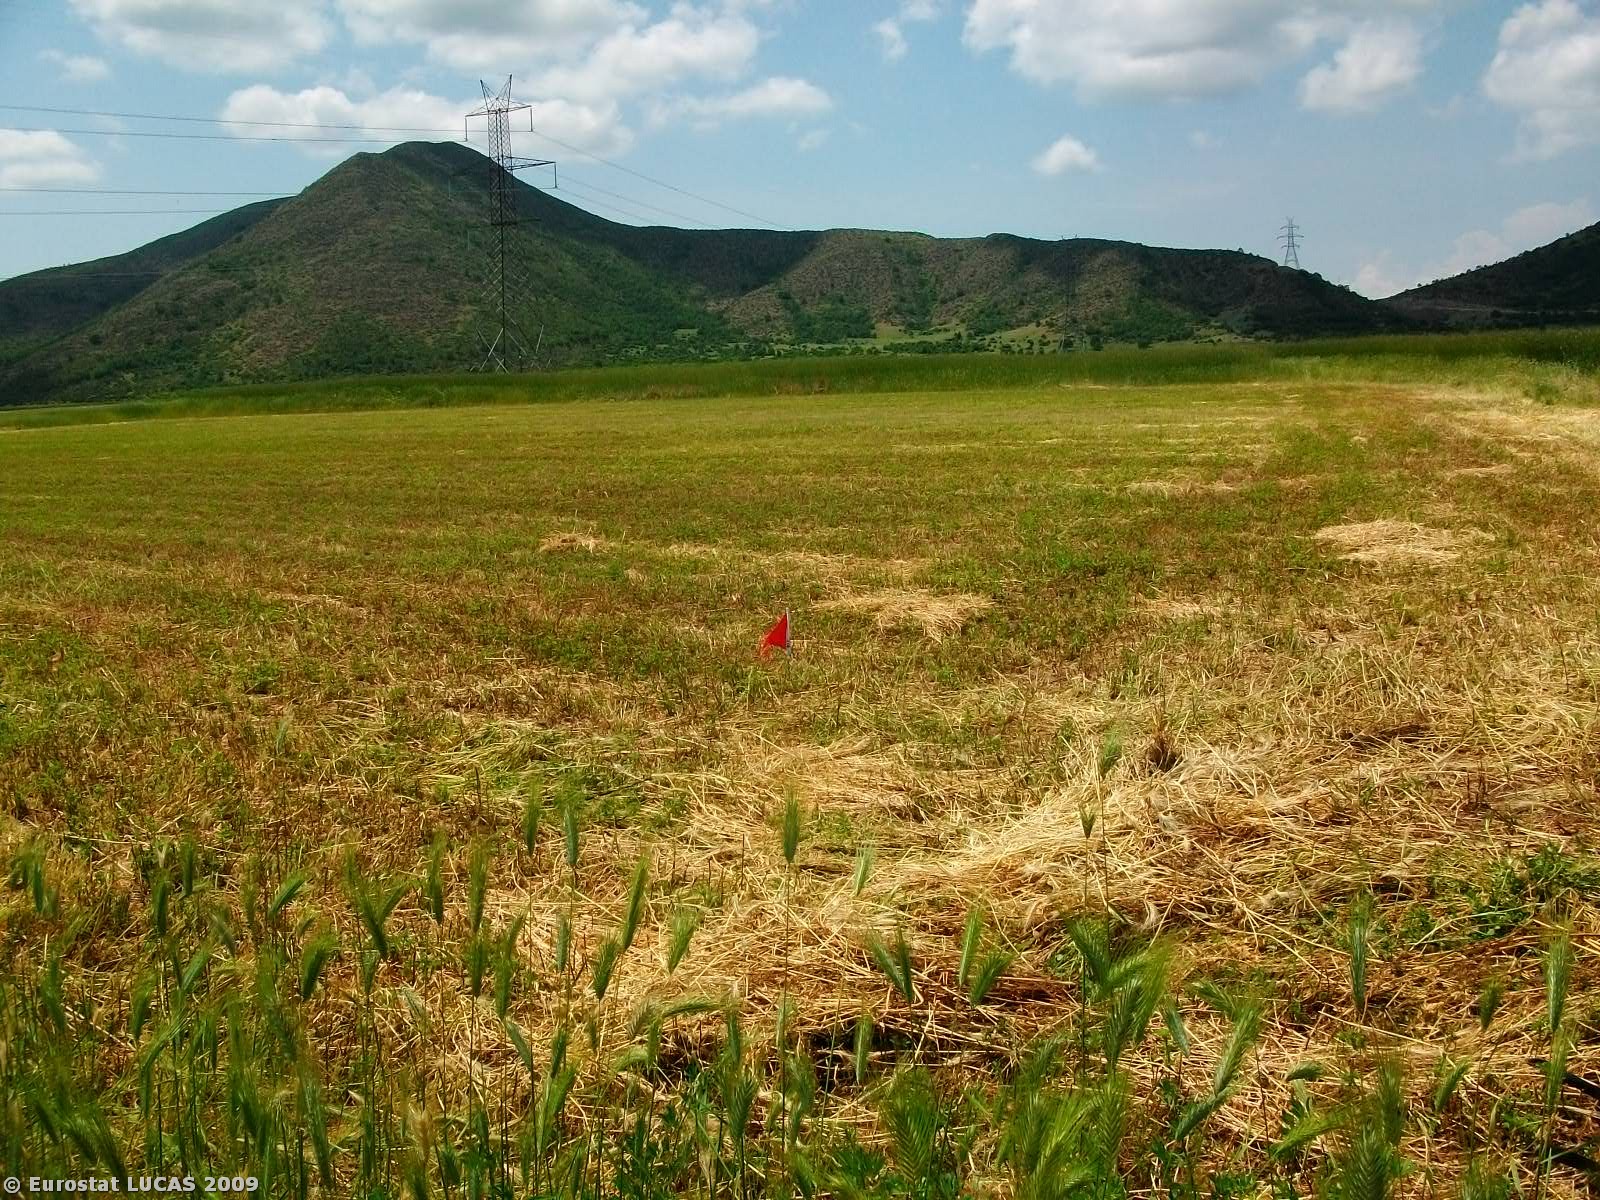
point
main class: Cropland
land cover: Lucerne
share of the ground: 25 - 50 %
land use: Agriculture (excluding fallow land and kitchen gardens)
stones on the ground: 10 - 25 %
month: May
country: GR
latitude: 40.1114
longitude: 21.7098
